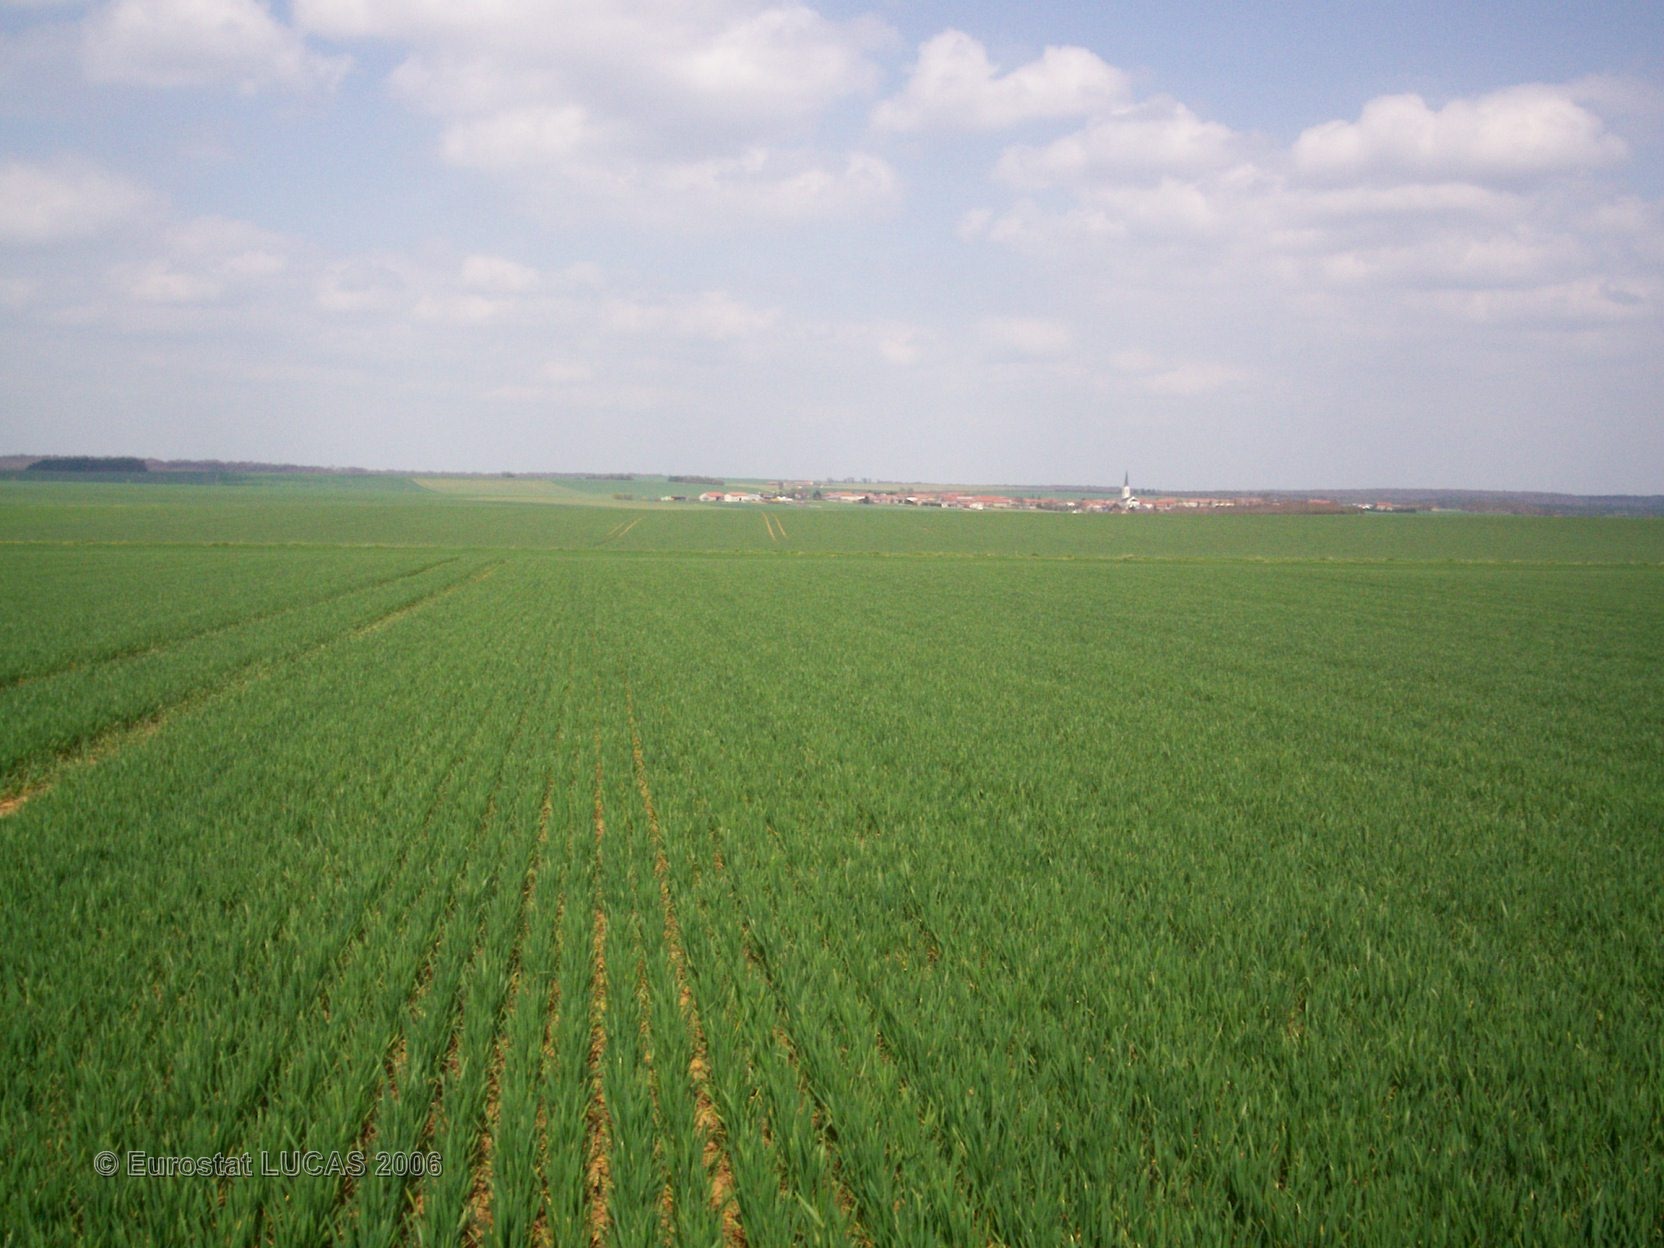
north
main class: Cropland
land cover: Common wheat
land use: Agriculture (excluding fallow land and kitchen gardens)
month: April
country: FR
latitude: 48.8678
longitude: 5.8961
